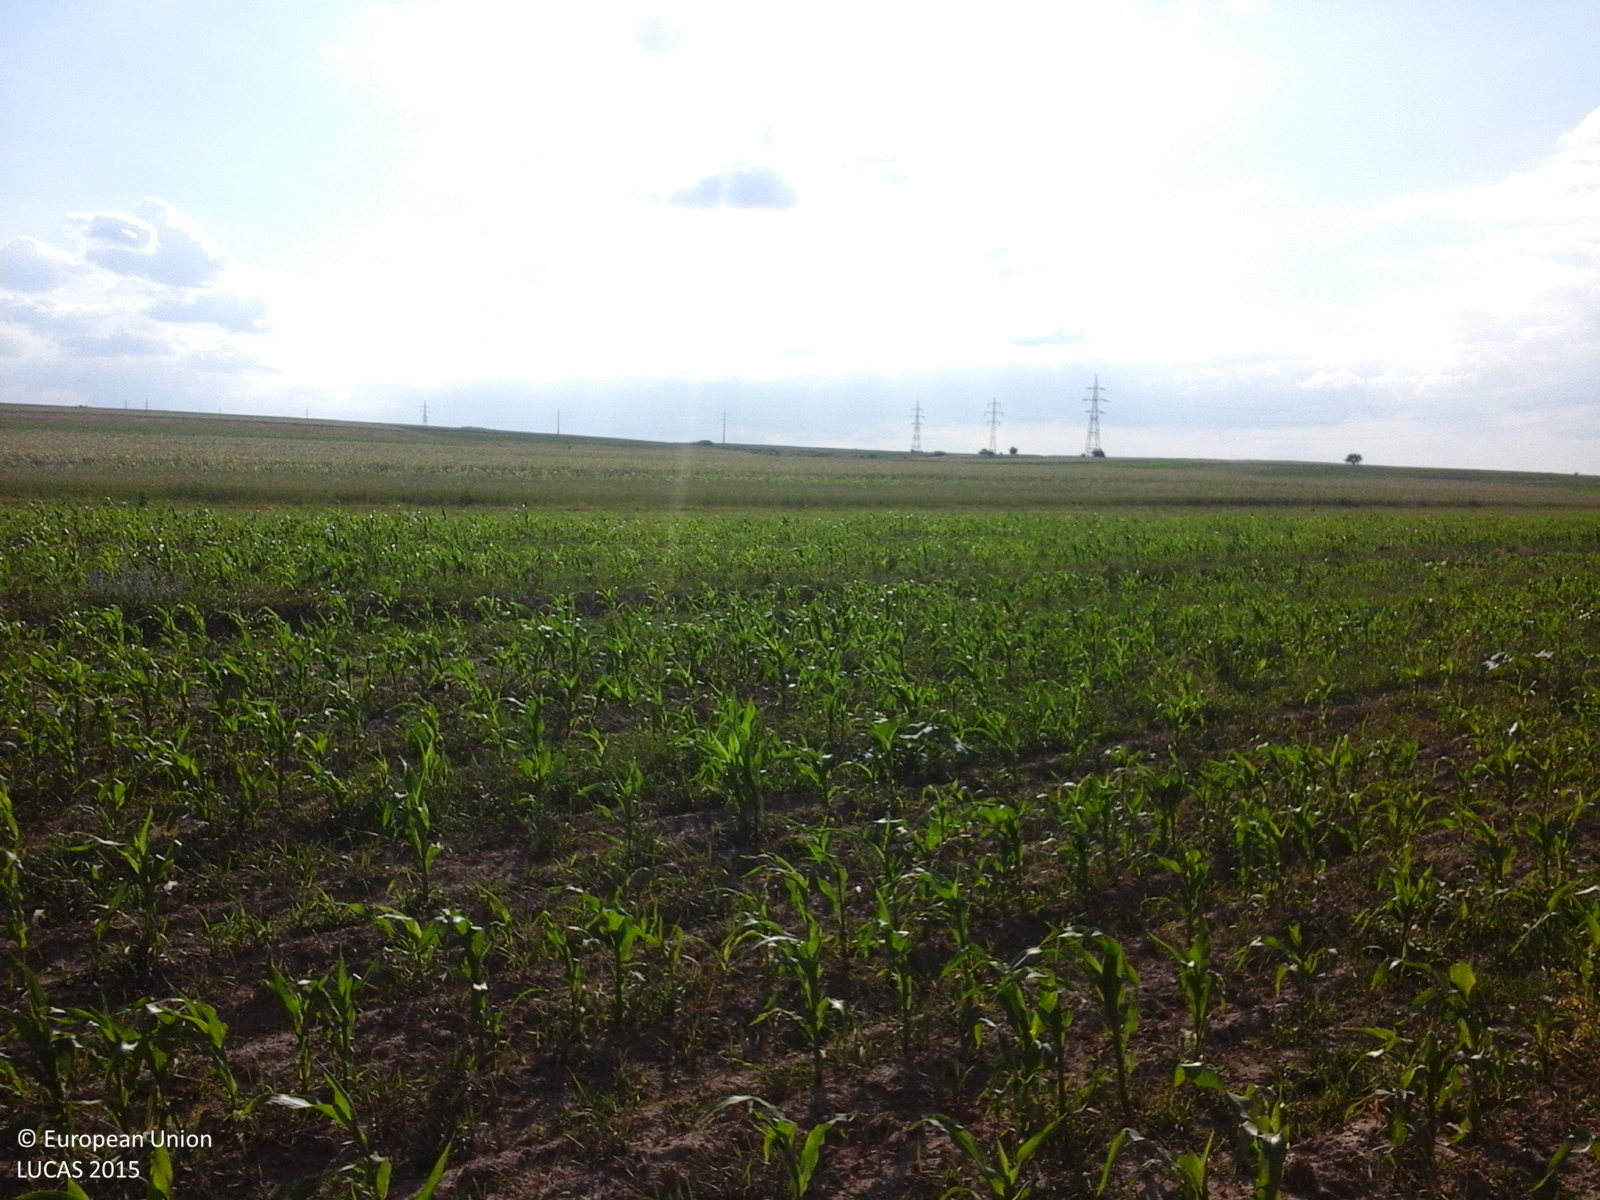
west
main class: Cropland
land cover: Common wheat
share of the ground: > 75 %
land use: Agriculture (excluding fallow land and kitchen gardens)
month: June
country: RO
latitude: 47.7414
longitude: 26.3705
